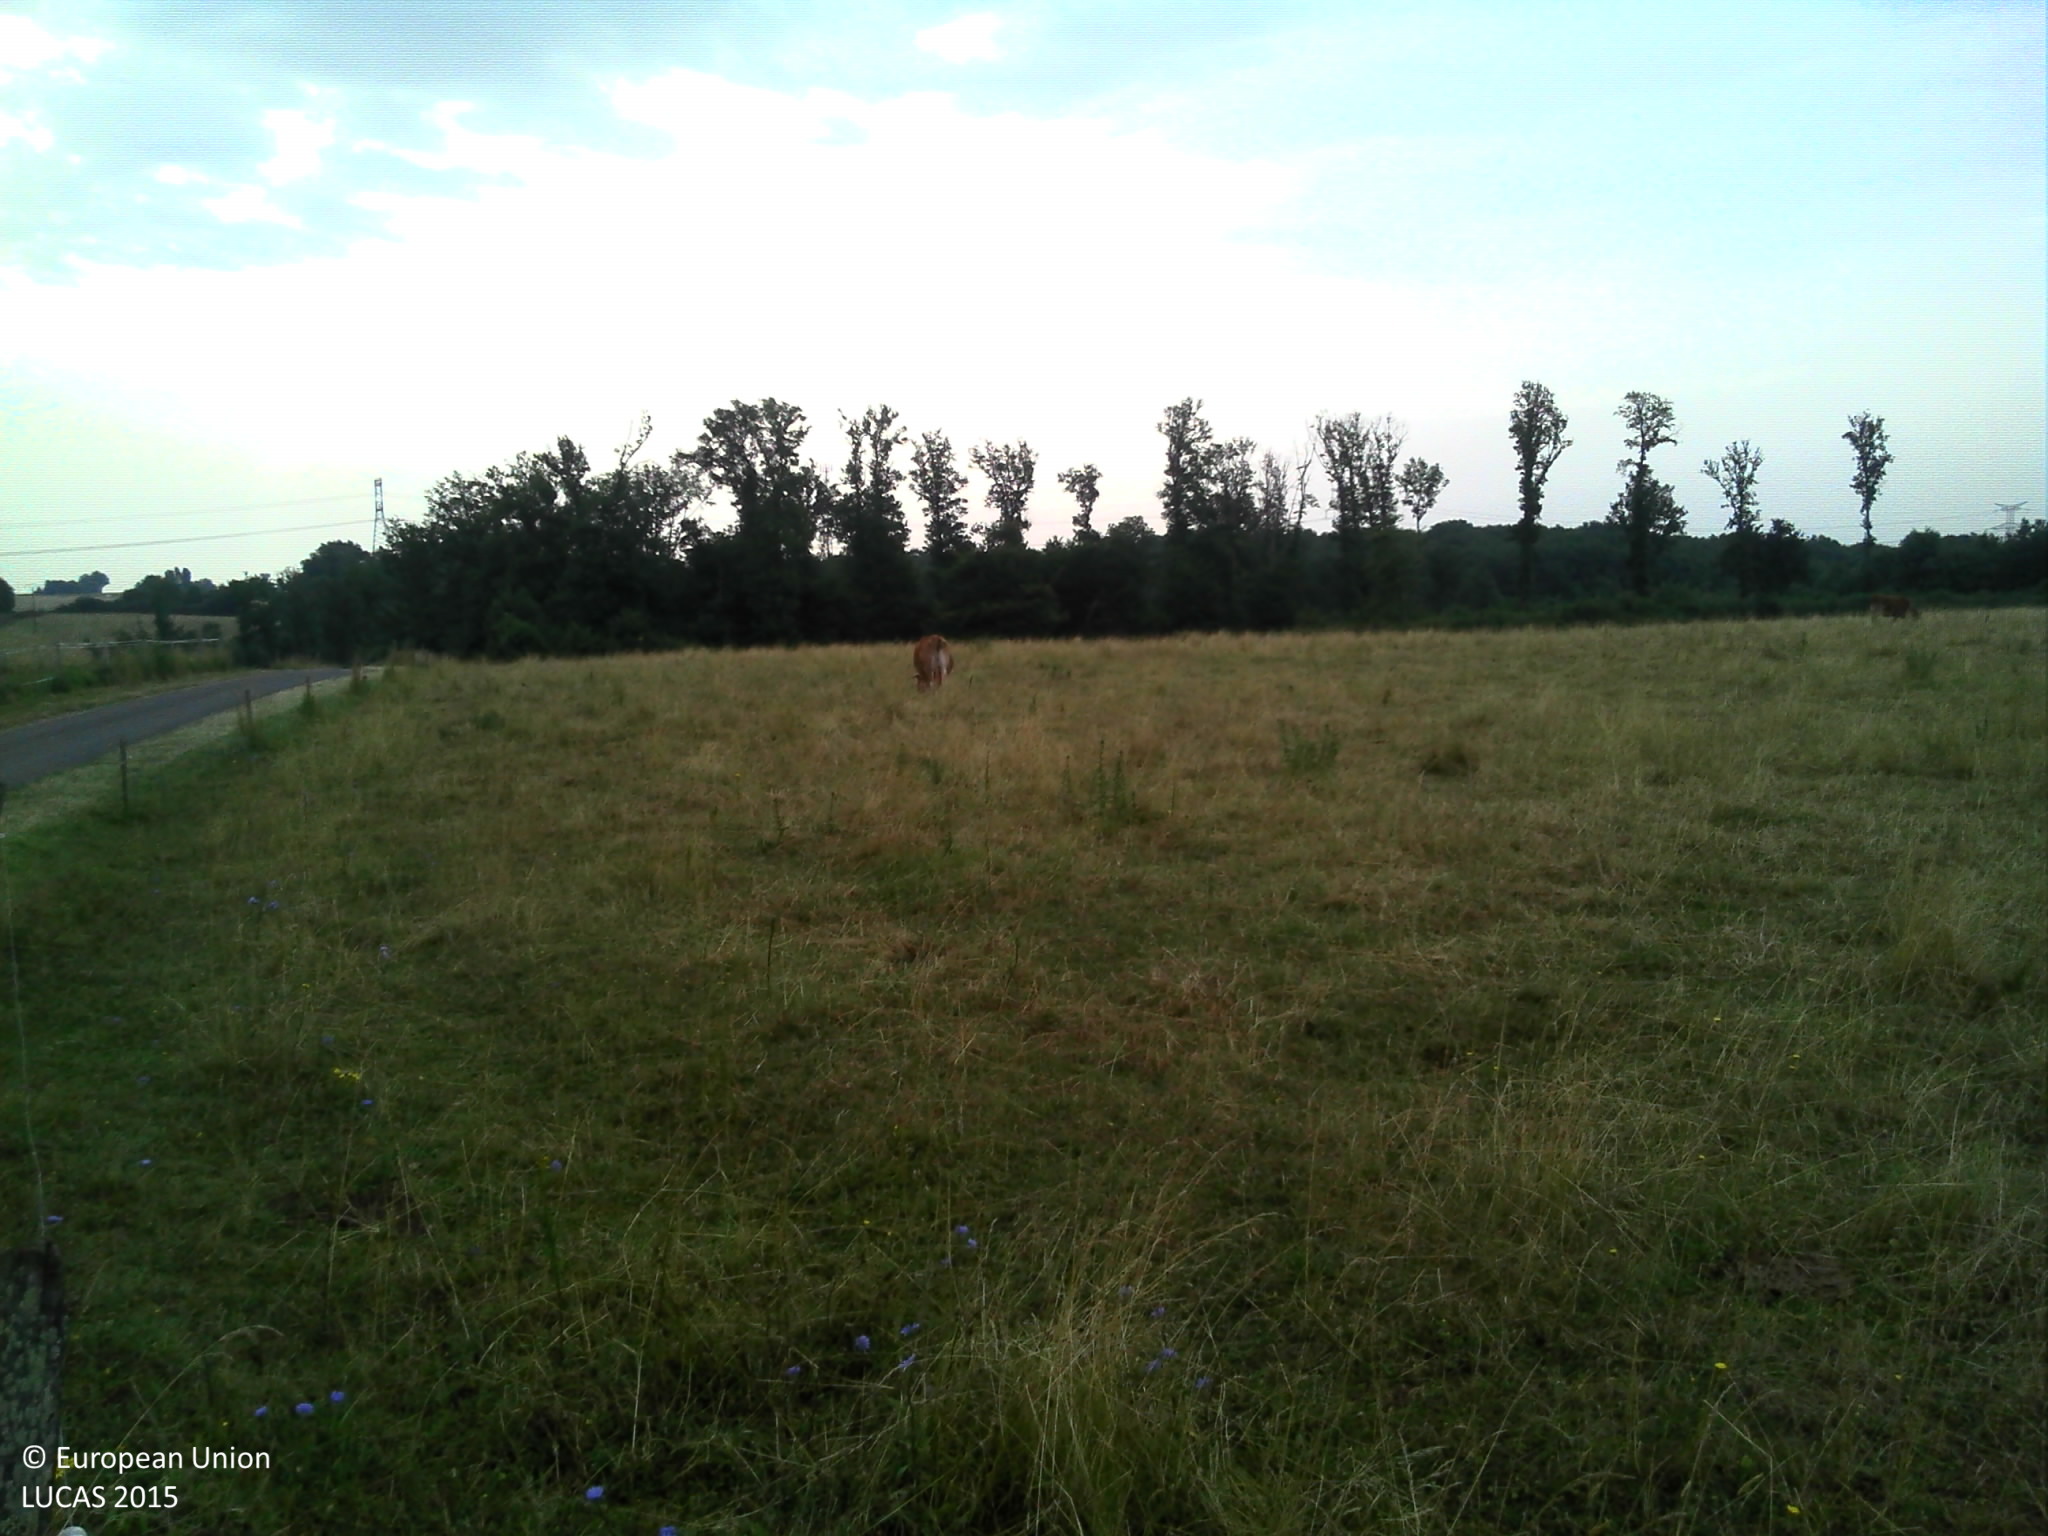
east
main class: Grassland
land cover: Grassland without tree/shrub cover
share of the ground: > 75 %
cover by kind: herbaceous plants 100 %
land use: Agriculture (excluding fallow land and kitchen gardens)
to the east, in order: Grassland without tree/shrub cover; Fences; Broadleaved woodland
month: July
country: FR
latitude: 46.4283
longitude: 0.6274
